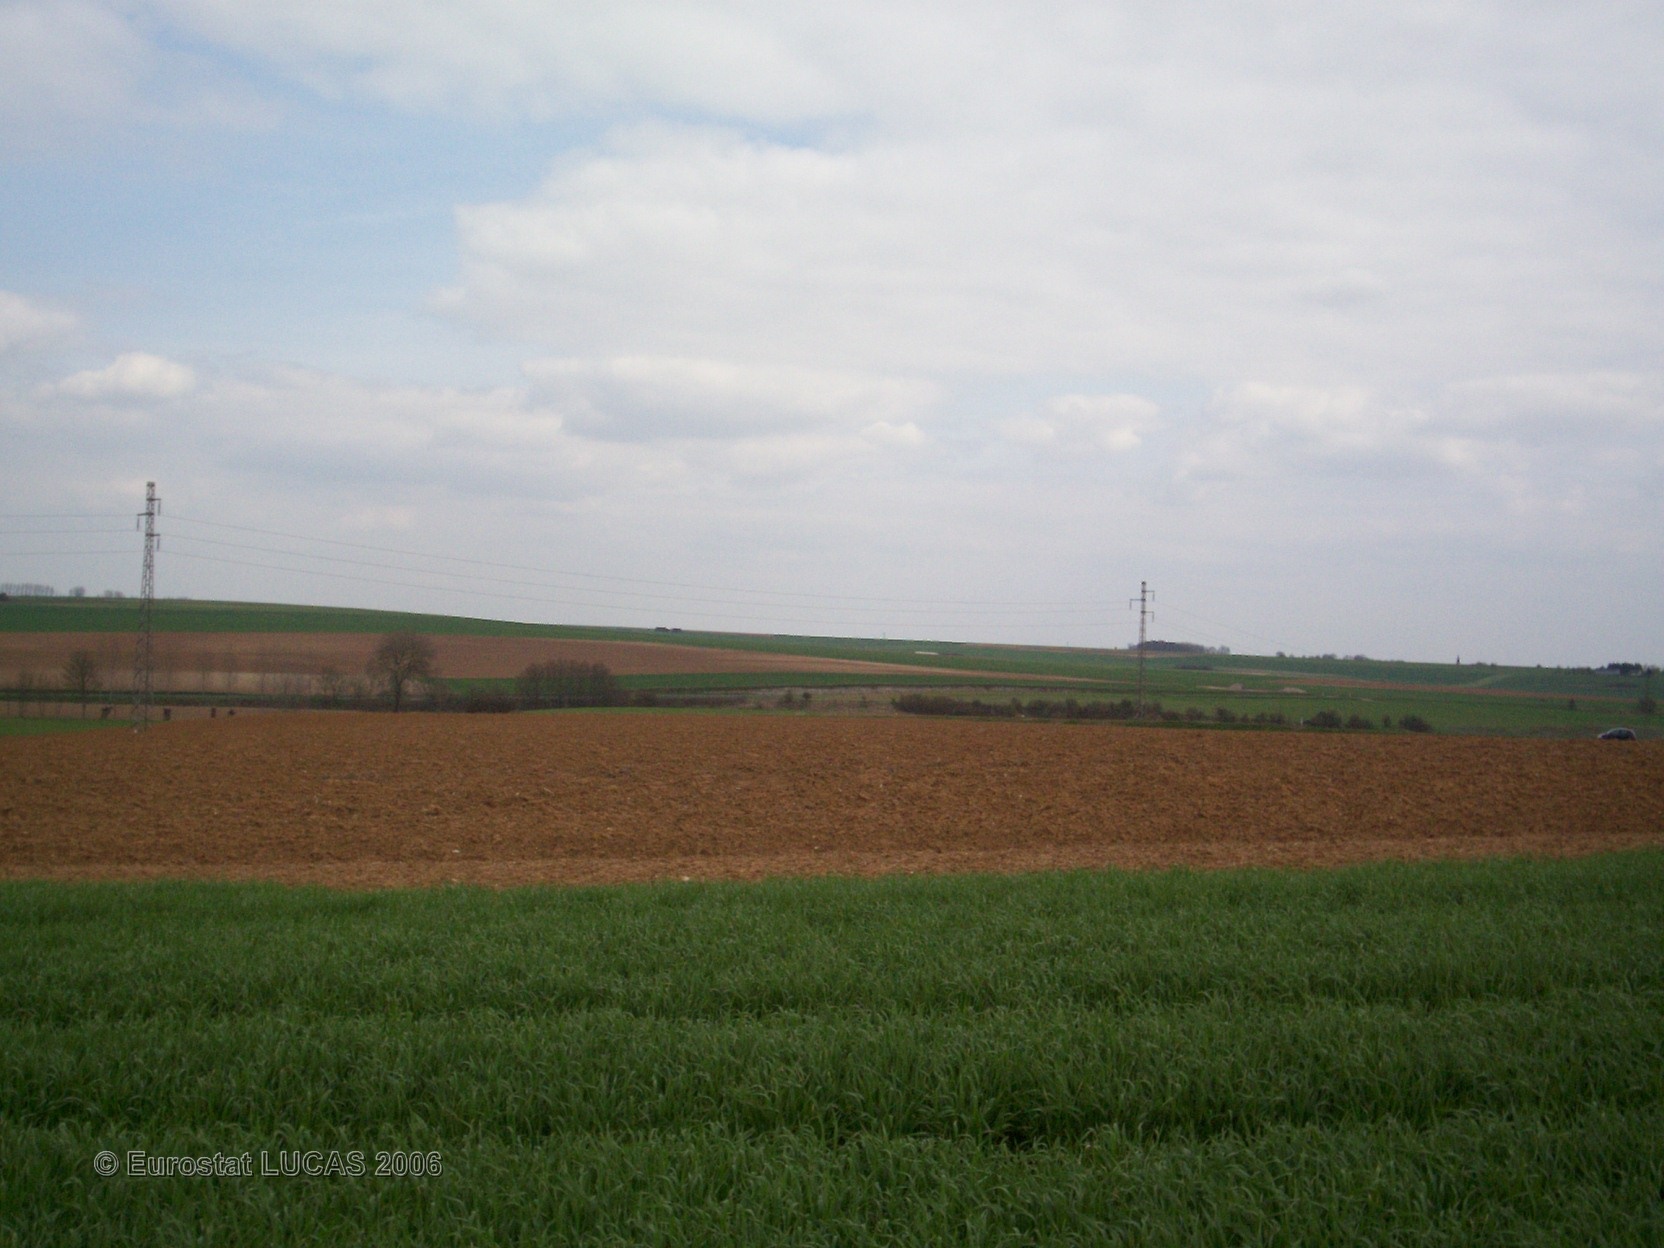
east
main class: Cropland
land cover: Common wheat
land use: Agriculture (excluding fallow land and kitchen gardens)
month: April
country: FR
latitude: 50.0323
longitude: 2.5750
